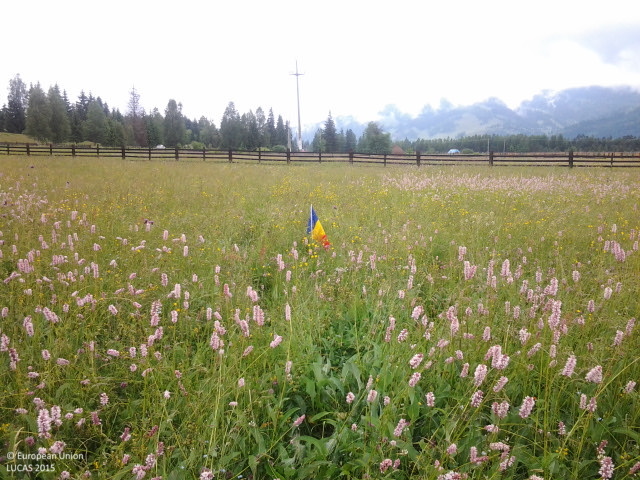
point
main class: Grassland
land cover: Grassland without tree/shrub cover
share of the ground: > 75 %
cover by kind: herbaceous plants 100 %
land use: Agriculture (excluding fallow land and kitchen gardens)
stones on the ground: < 10 %
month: June
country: RO
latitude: 47.2507
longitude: 25.3452
